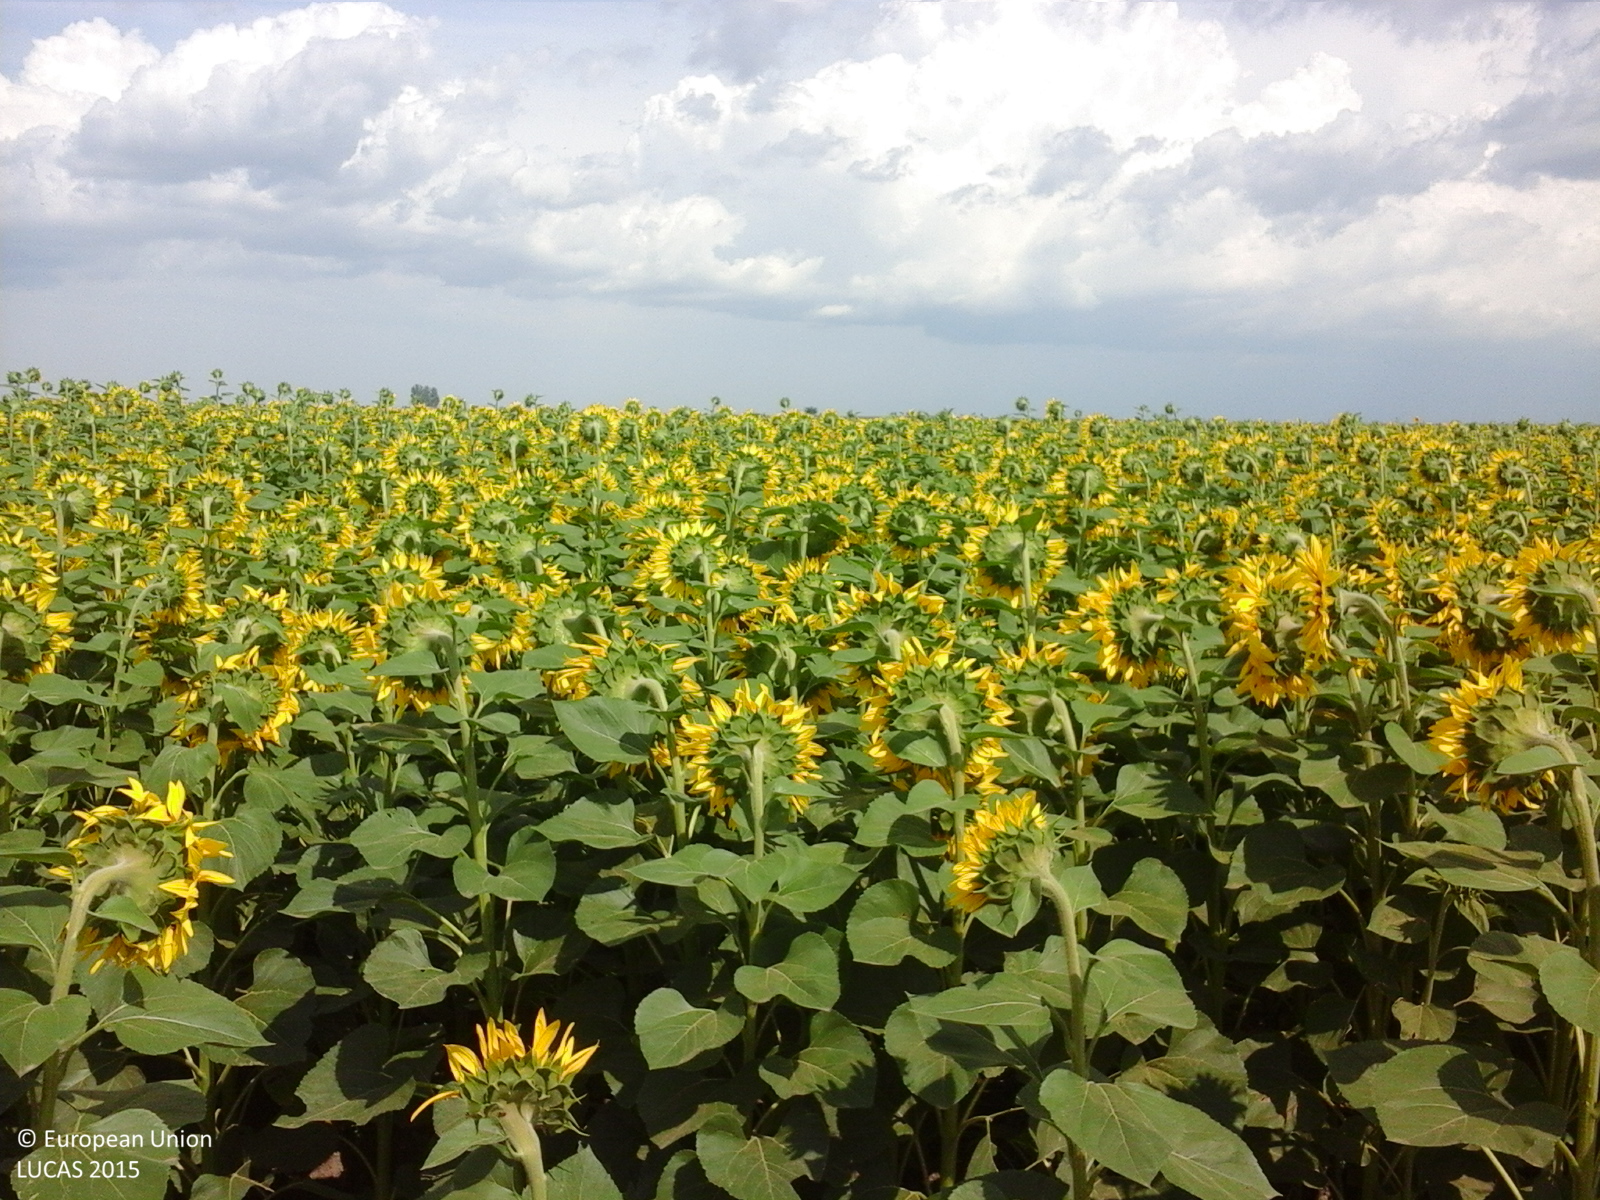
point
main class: Cropland
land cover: Sunflower
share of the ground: > 75 %
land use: Agriculture (excluding fallow land and kitchen gardens)
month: July
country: RO
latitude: 43.8230
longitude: 24.3486
